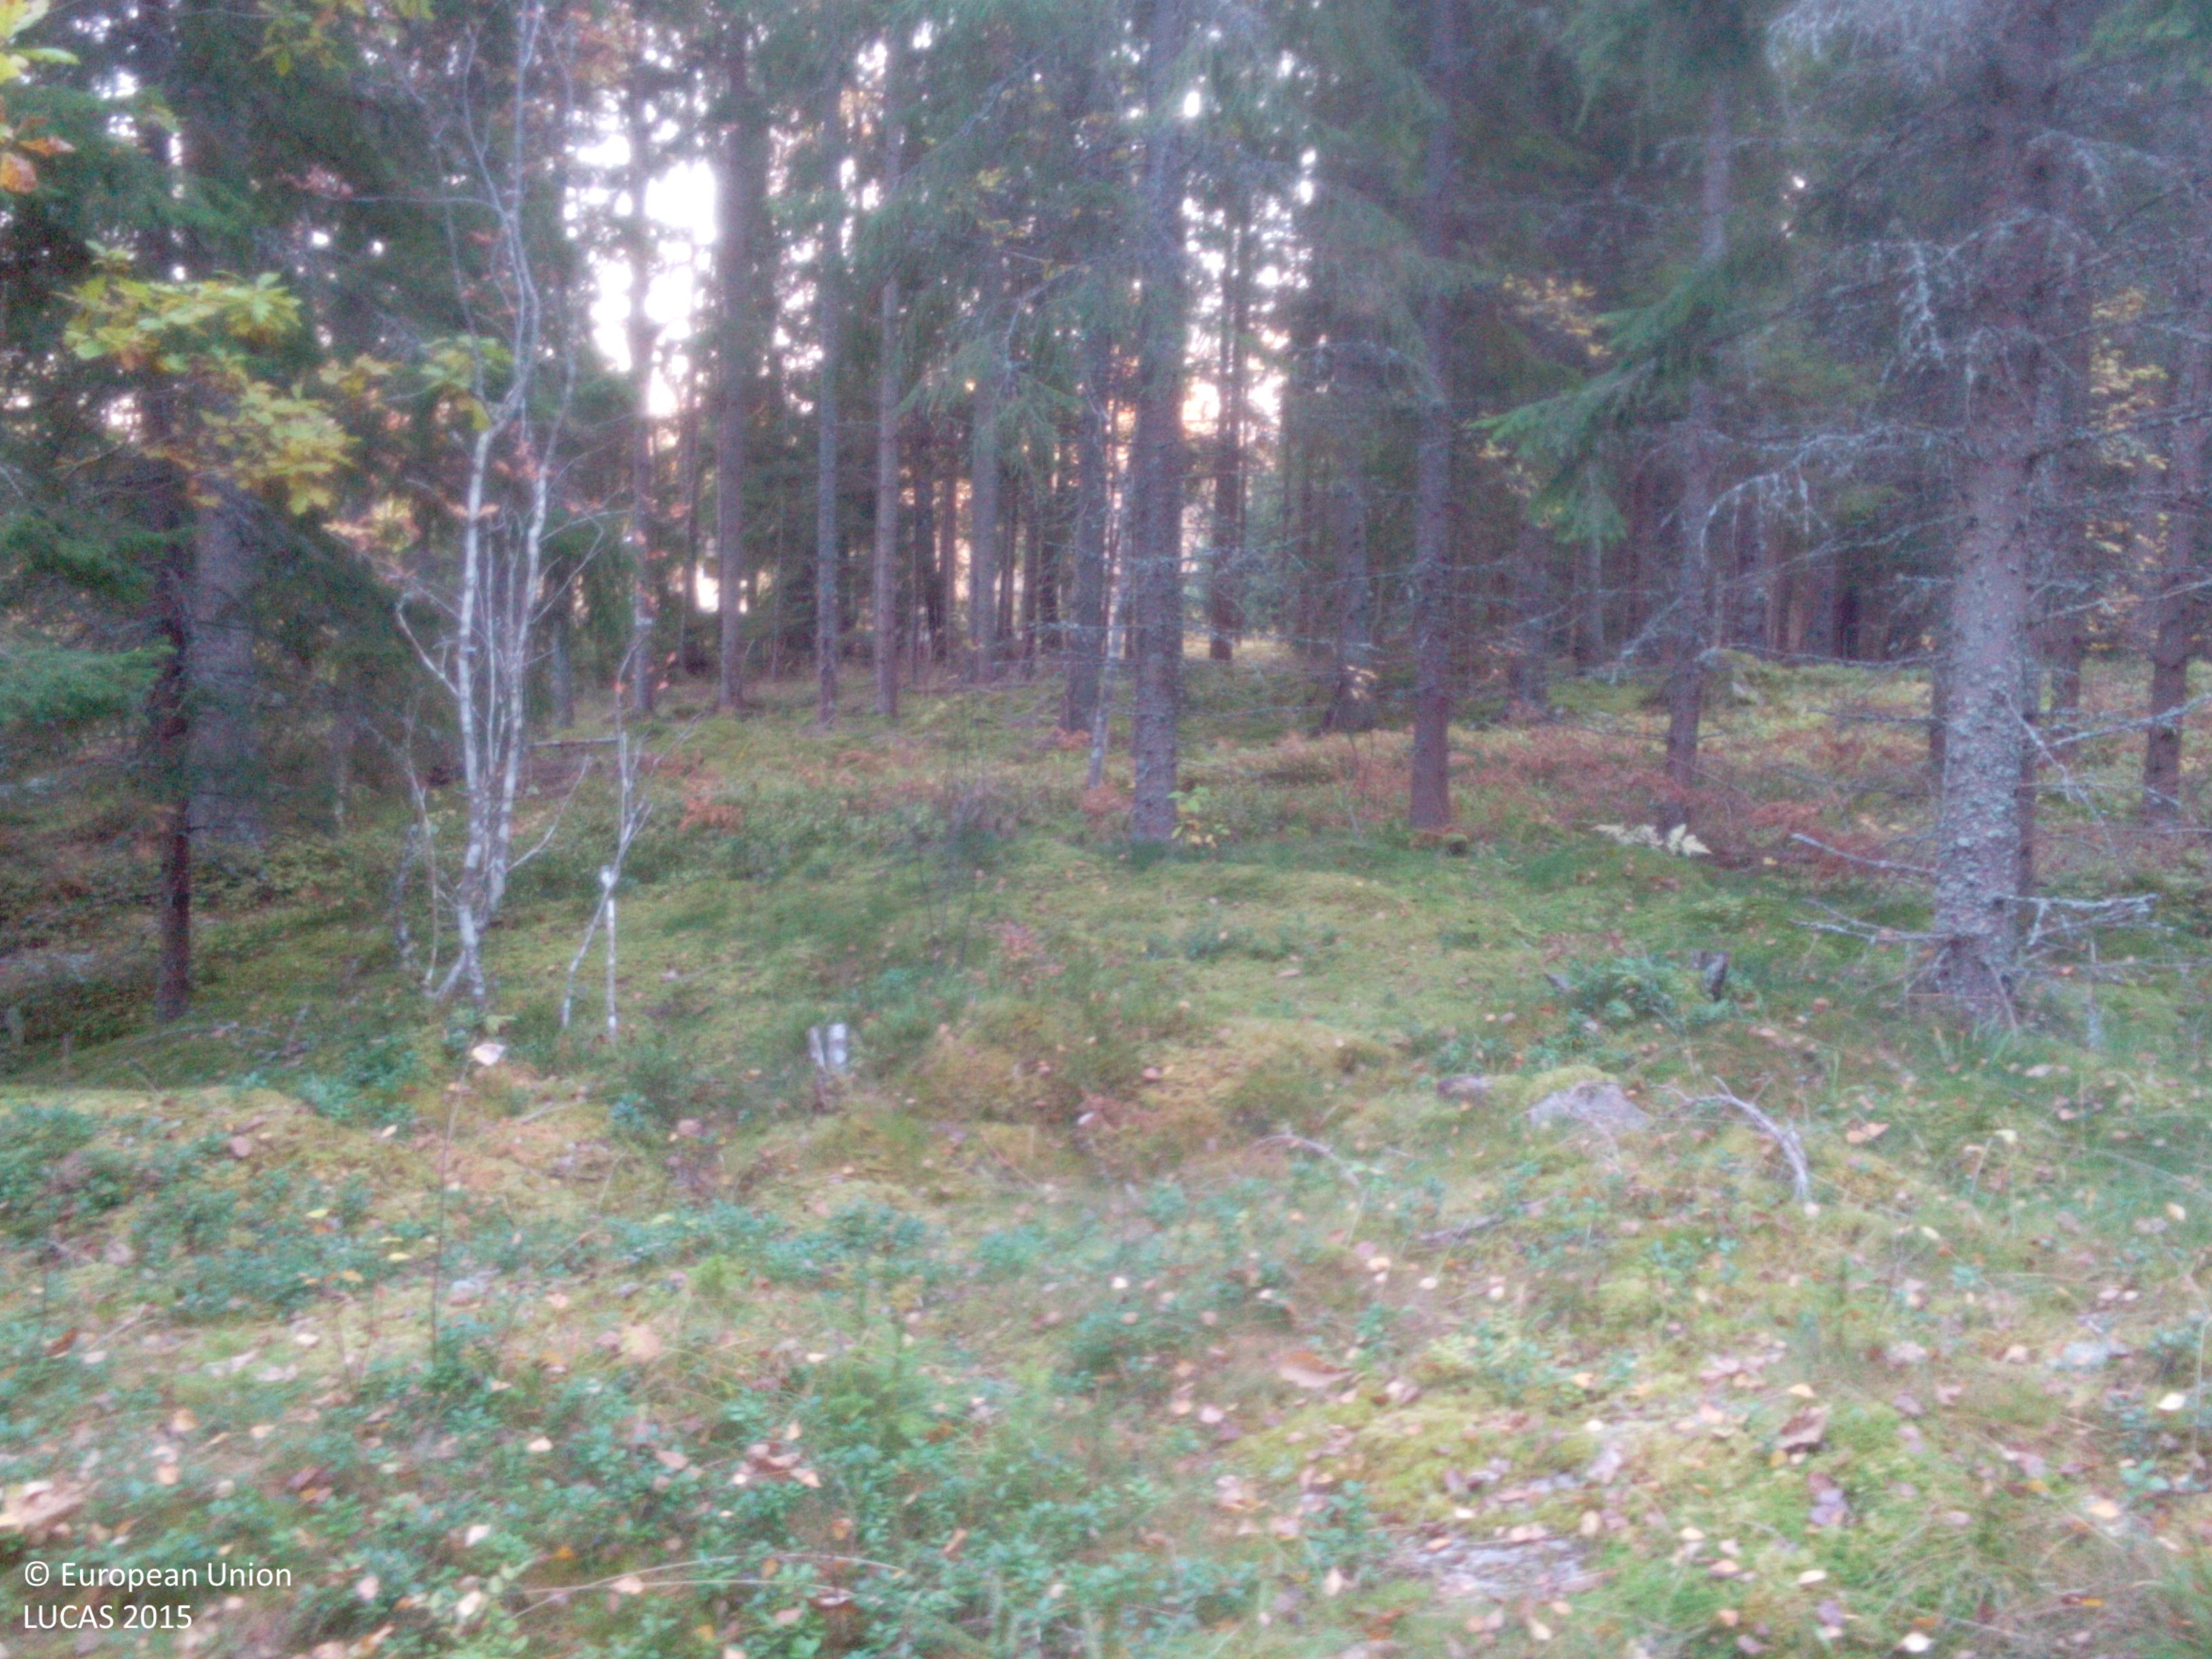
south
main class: Woodland
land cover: Spruce dominated coniferous woodland
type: boreal forest
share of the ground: 50 - 75 %
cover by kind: coniferous forest trees 50 %, herbaceous plants 35 %, broadleaved forest trees 10 %, lichens and mosses 5 %
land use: Forestry
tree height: > 5 m
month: October
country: SE
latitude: 58.8455
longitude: 16.3546
